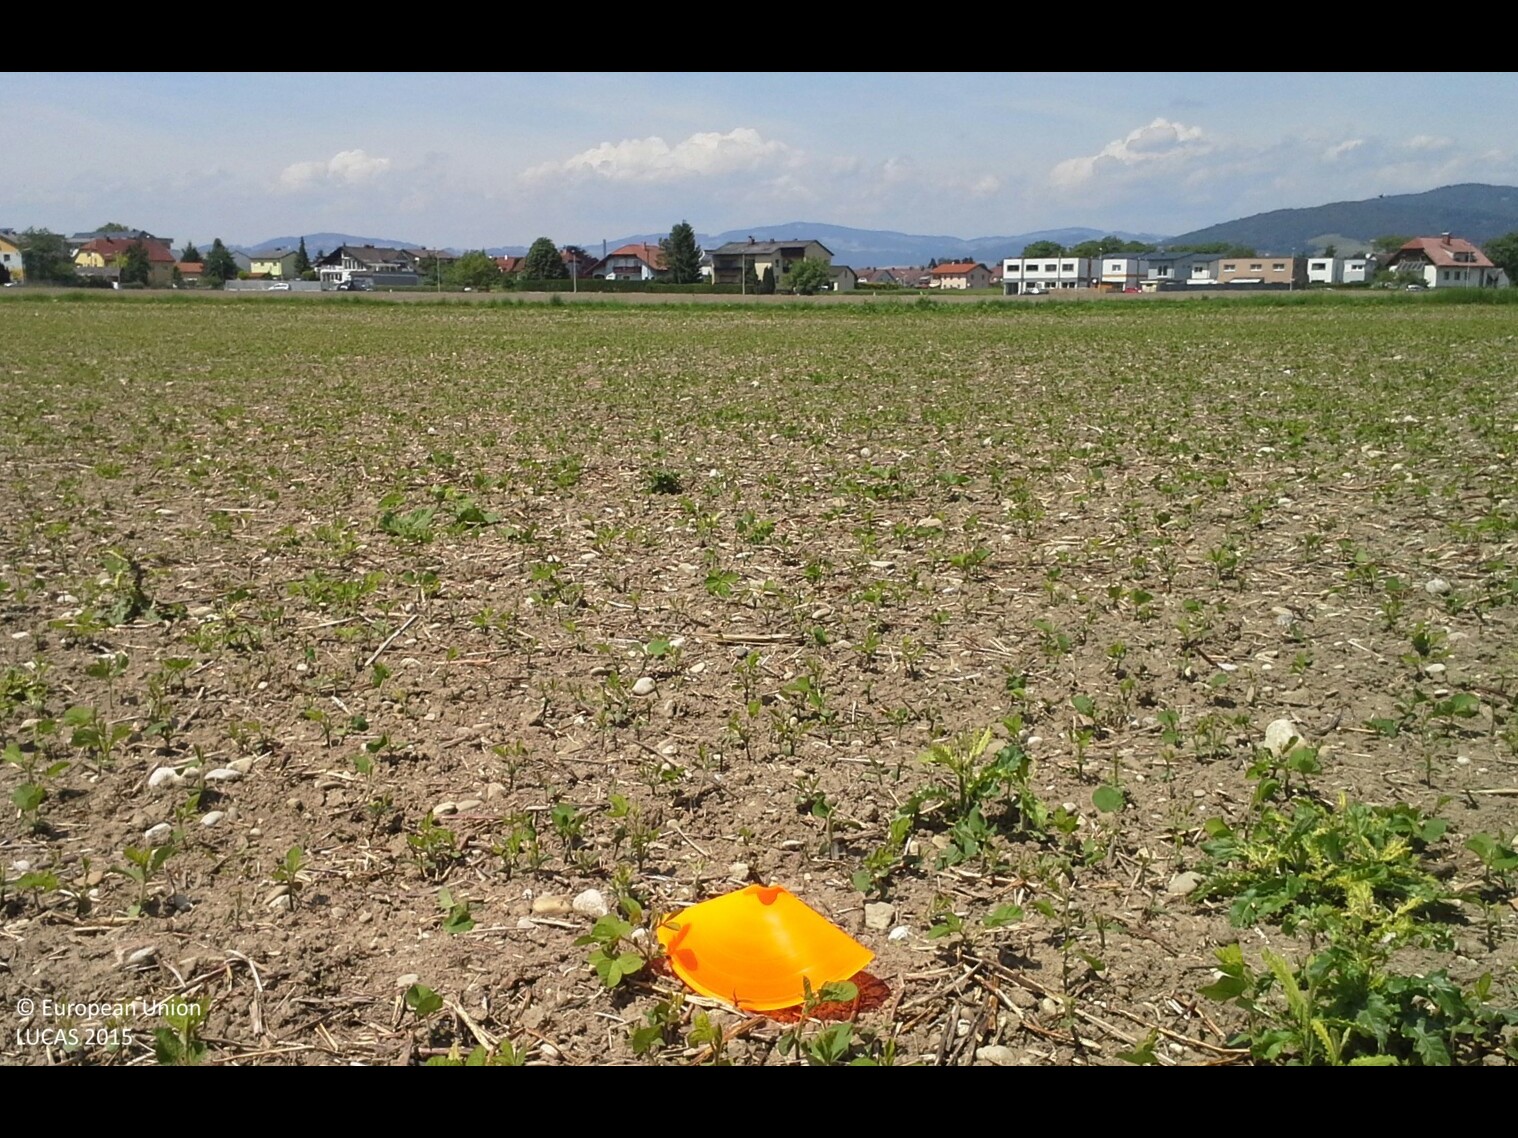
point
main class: Cropland
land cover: Soya
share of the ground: 10 - 25 %
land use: Agriculture (excluding fallow land and kitchen gardens)
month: May
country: AT
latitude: 48.2448
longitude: 14.3767
